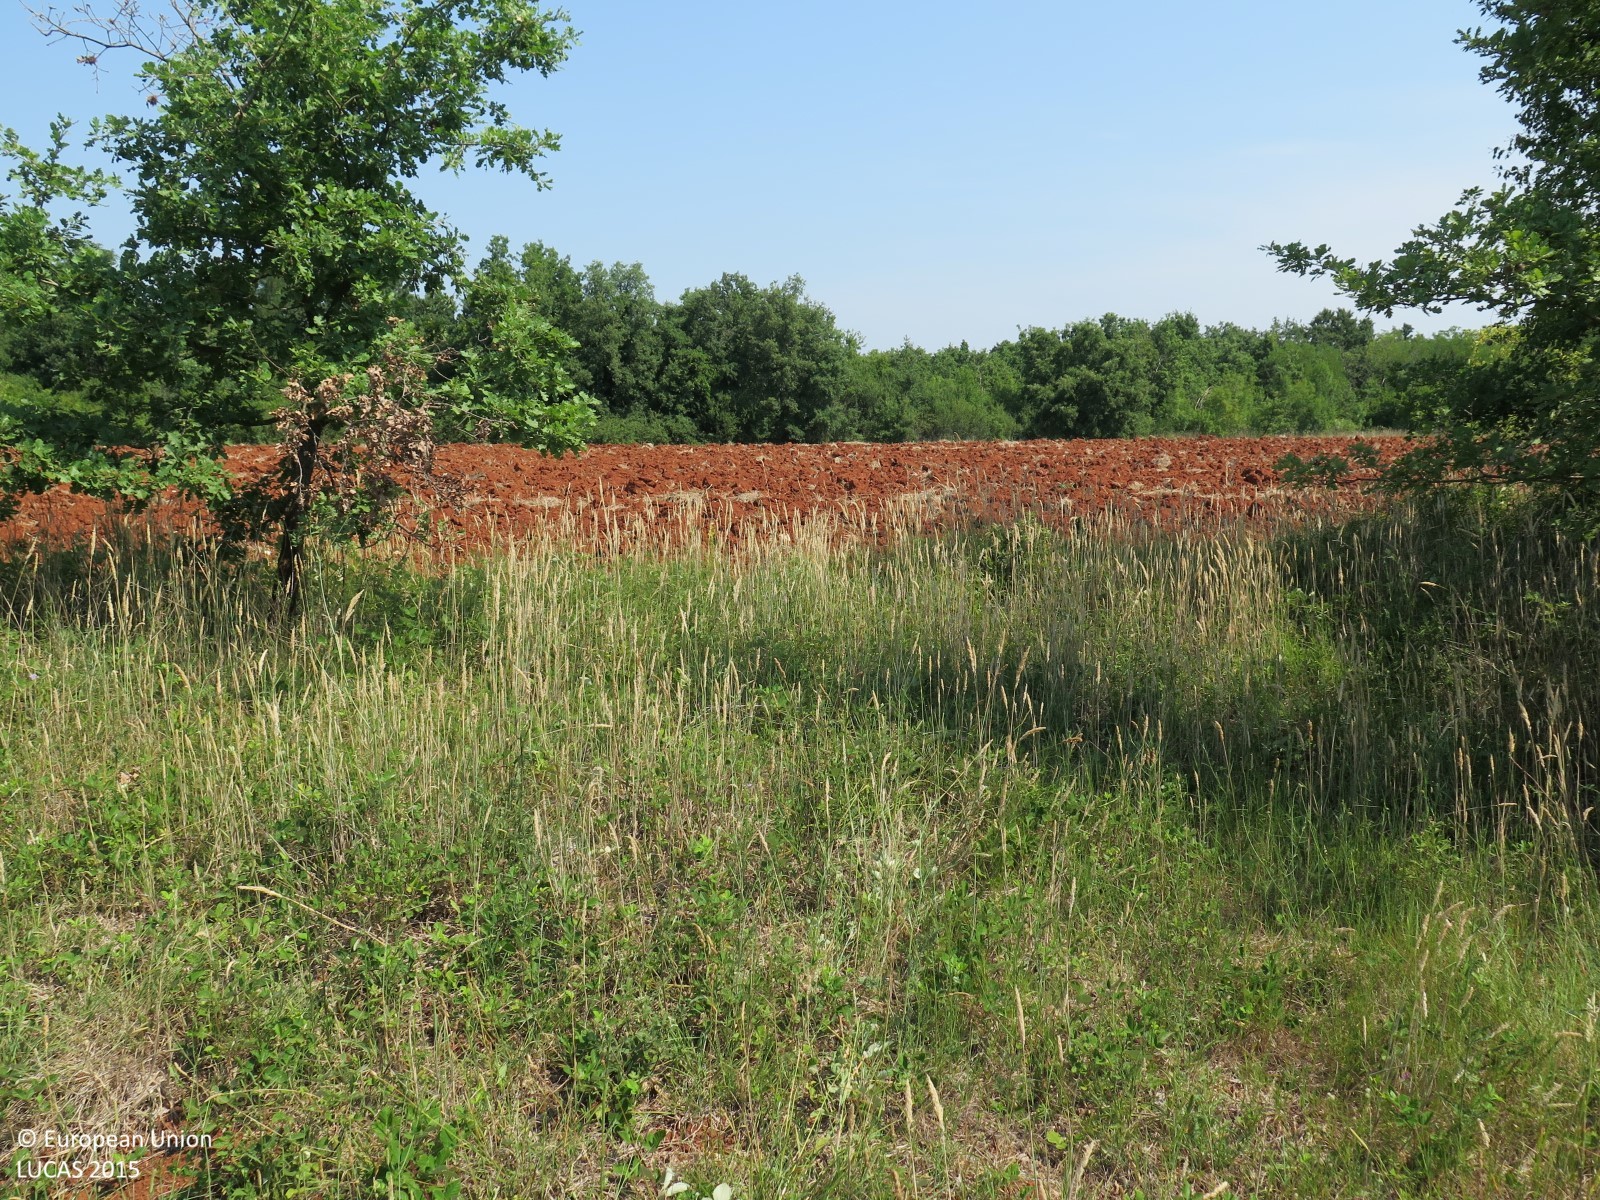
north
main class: Grassland
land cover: Grassland with sparse tree/shrub cover
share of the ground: > 75 %
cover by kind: herbaceous plants 90 %, broadleaved forest trees 5 %, shrubs 5 %
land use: Semi-natural and natural areas not in use
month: July
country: HR
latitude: 45.2788
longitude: 13.6536
